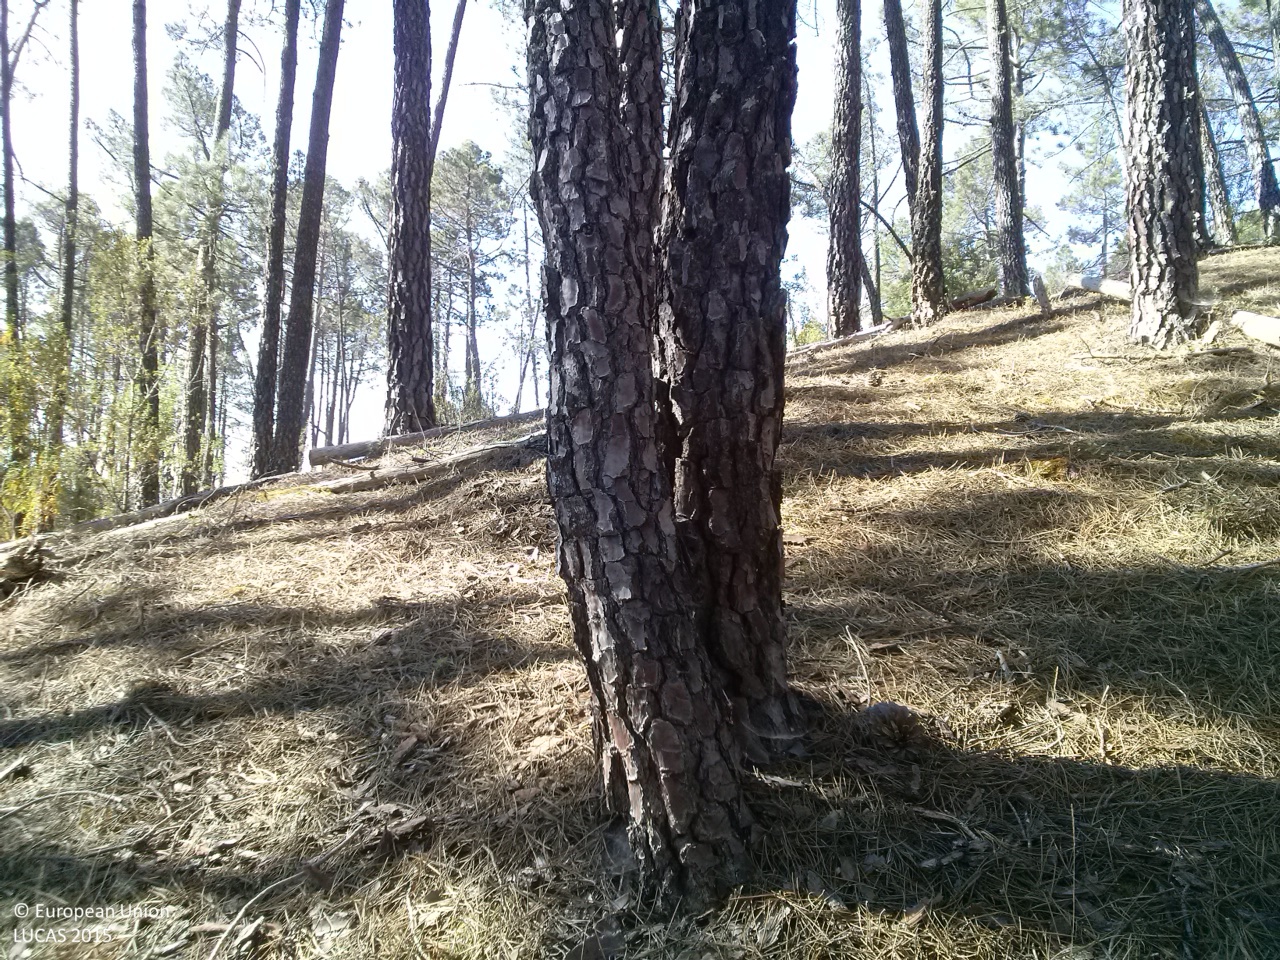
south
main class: Woodland
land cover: Pine dominated coniferous woodland
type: coniferous forest of the mediterranean region
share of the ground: > 75 %
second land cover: Shrubland without tree cover
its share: < 10 %
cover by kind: coniferous forest trees 85 %, shrubs 10 %, herbaceous plants 5 %
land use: Forestry
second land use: Agriculture (excluding fallow land and kitchen gardens)
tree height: > 5 m
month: June
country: ES
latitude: 39.9891
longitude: -1.6637
